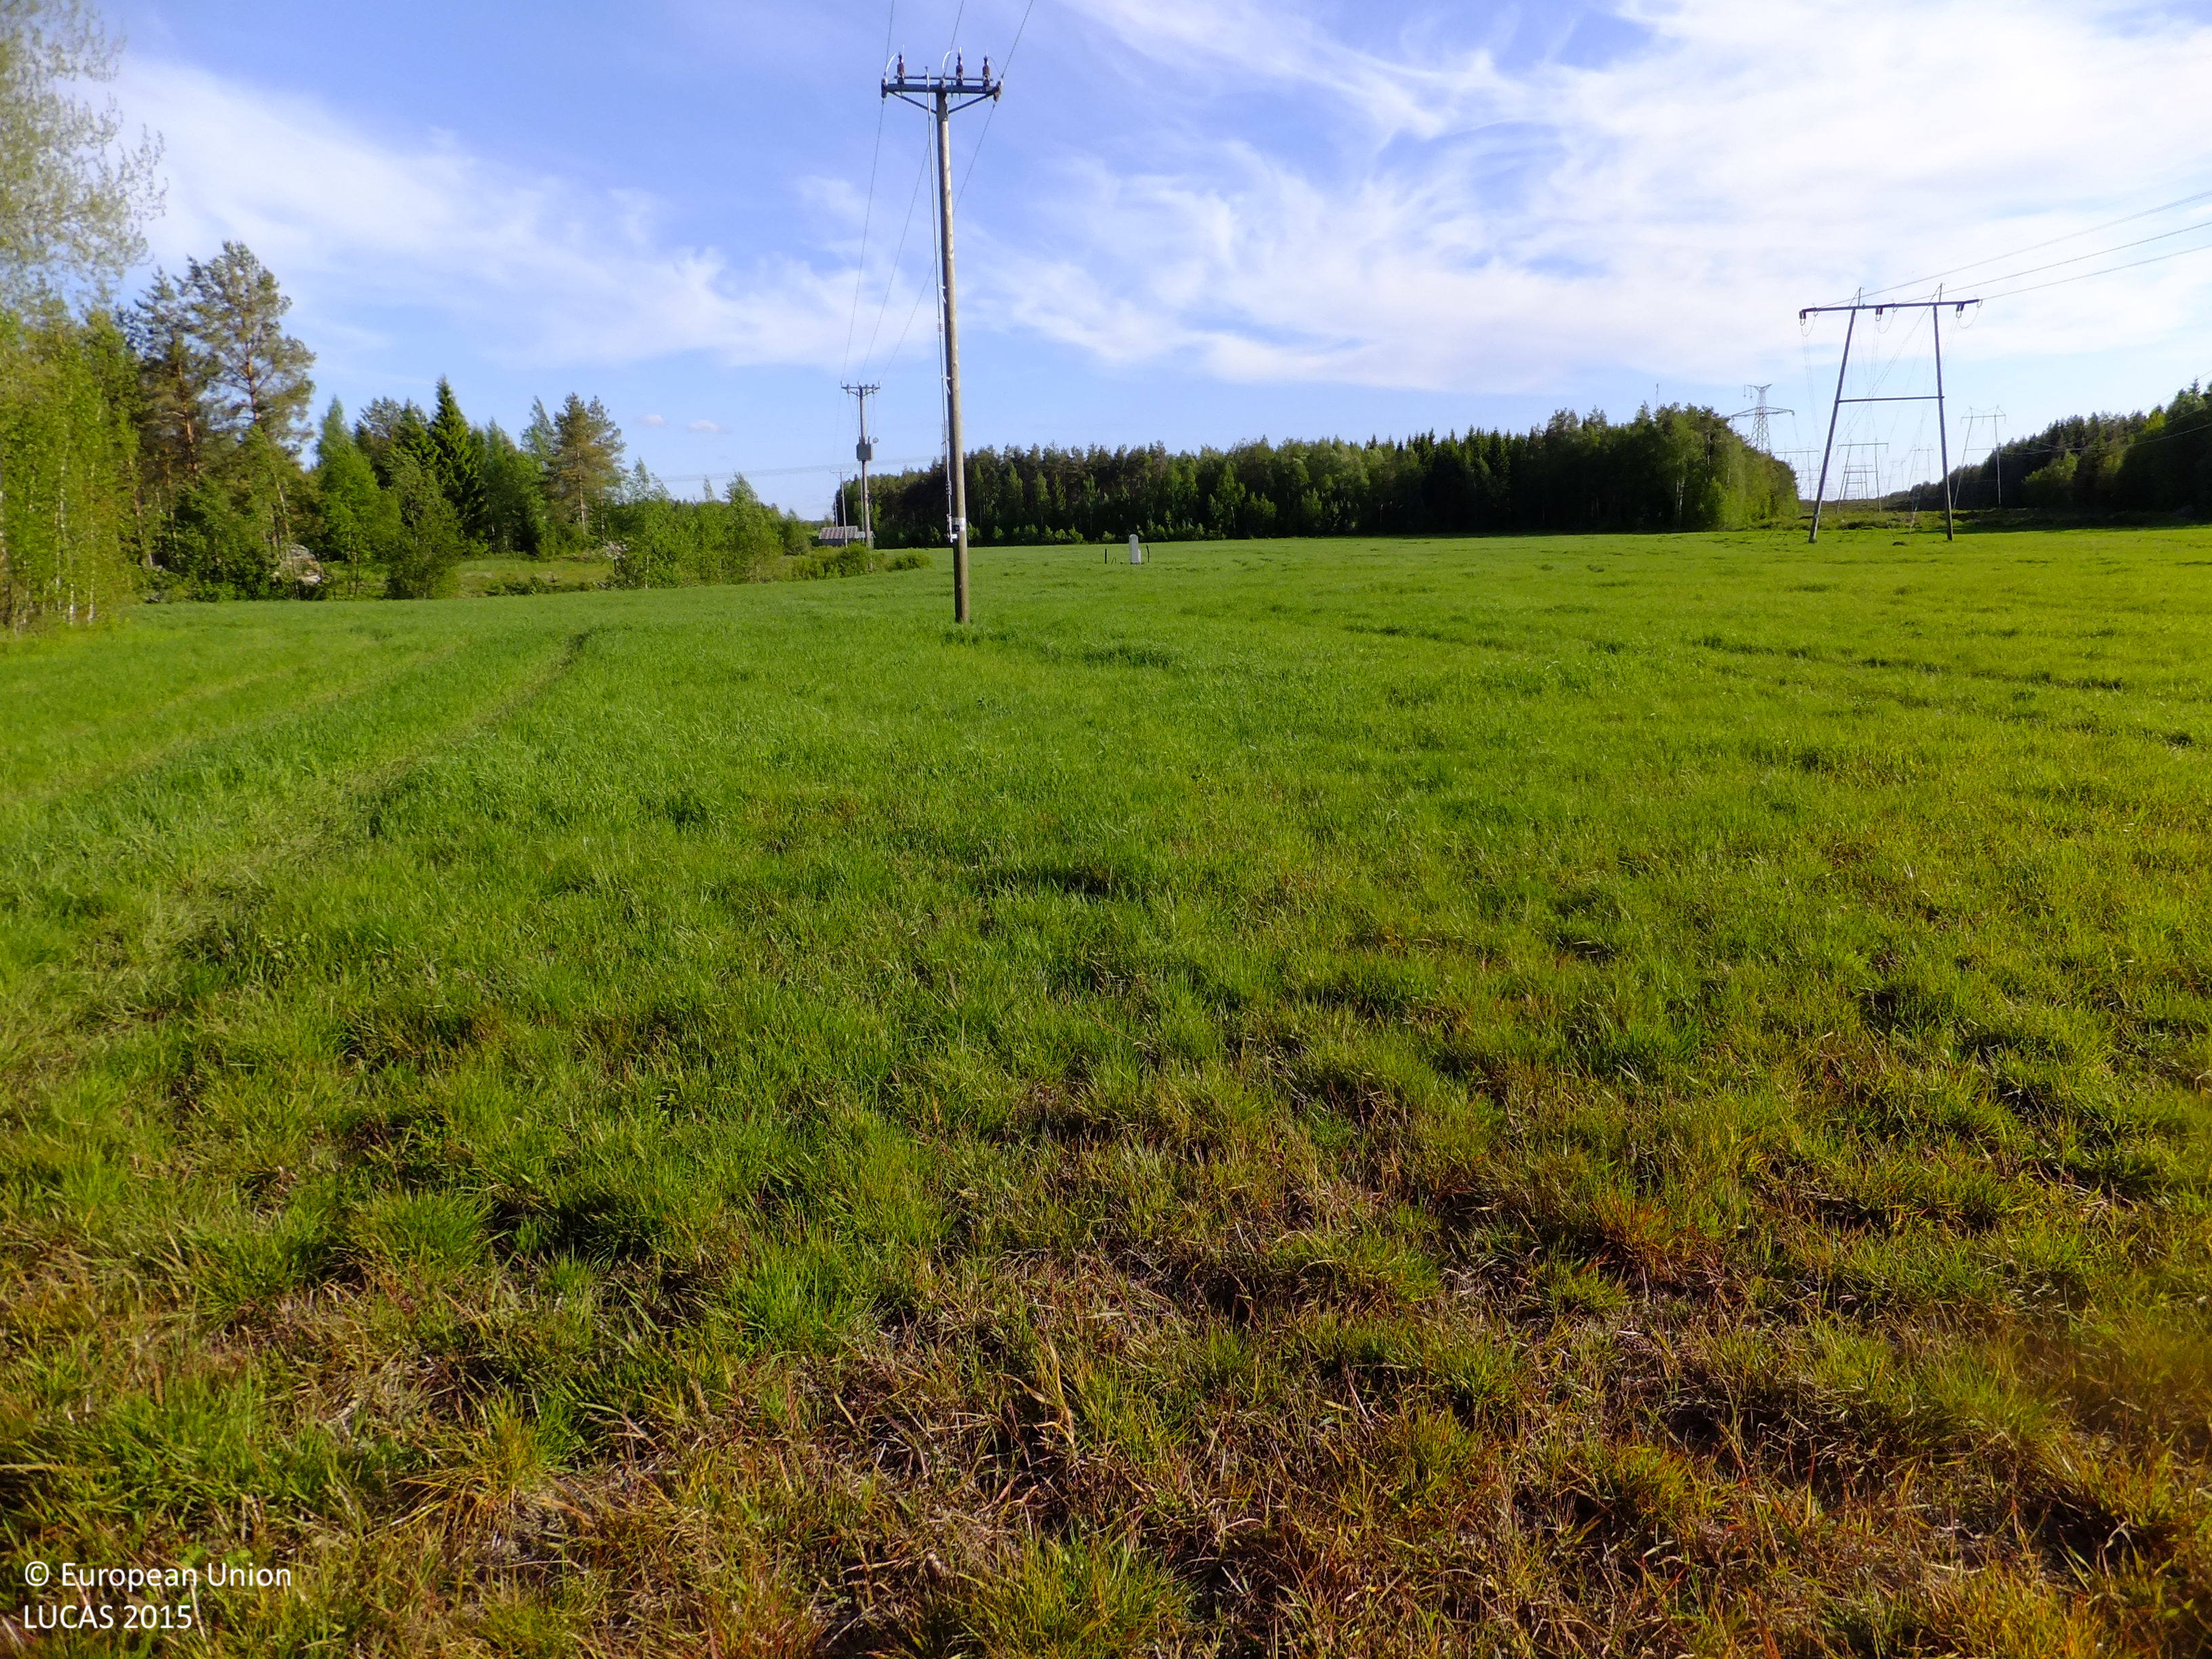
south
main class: Grassland
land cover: Grassland without tree/shrub cover
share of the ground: > 75 %
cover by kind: herbaceous plants 100 %
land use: Agriculture (excluding fallow land and kitchen gardens)
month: June
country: FI
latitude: 63.5050
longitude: 22.6464
